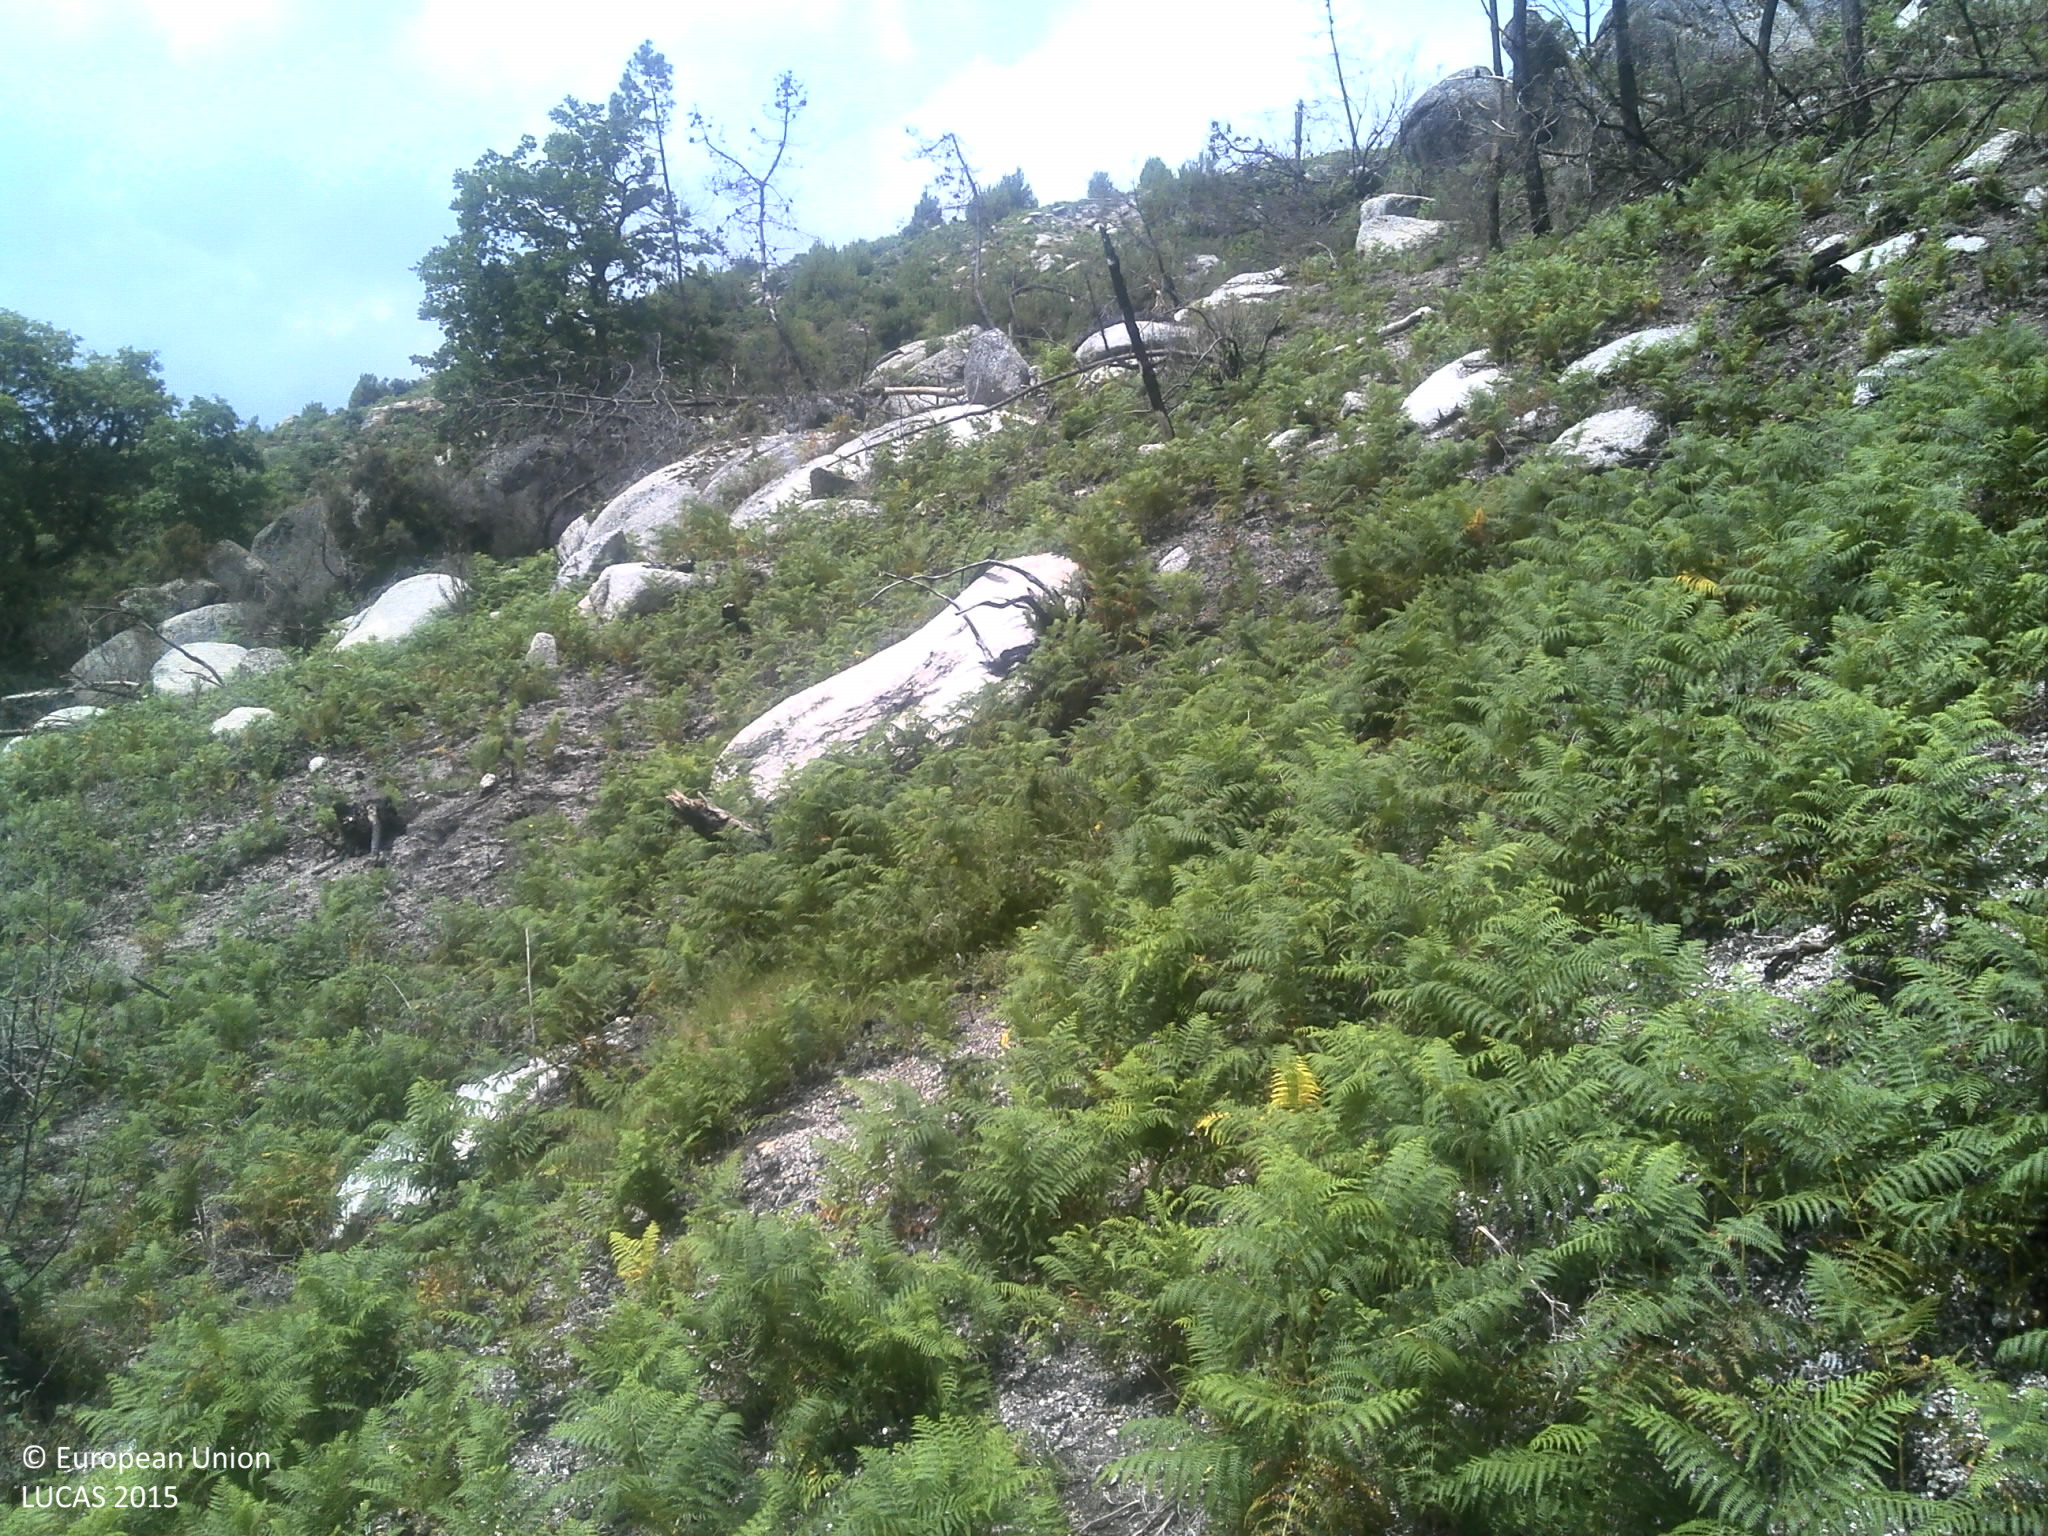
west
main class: Shrubland
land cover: Shrubland without tree cover
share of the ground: 50 - 75 %
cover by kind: shrubs 70 %, consolidated bare surface 20 %, unconsolidated bare surface 10 %
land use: Agriculture (excluding fallow land and kitchen gardens)
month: June
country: PT
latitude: 41.6846
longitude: -8.2309
